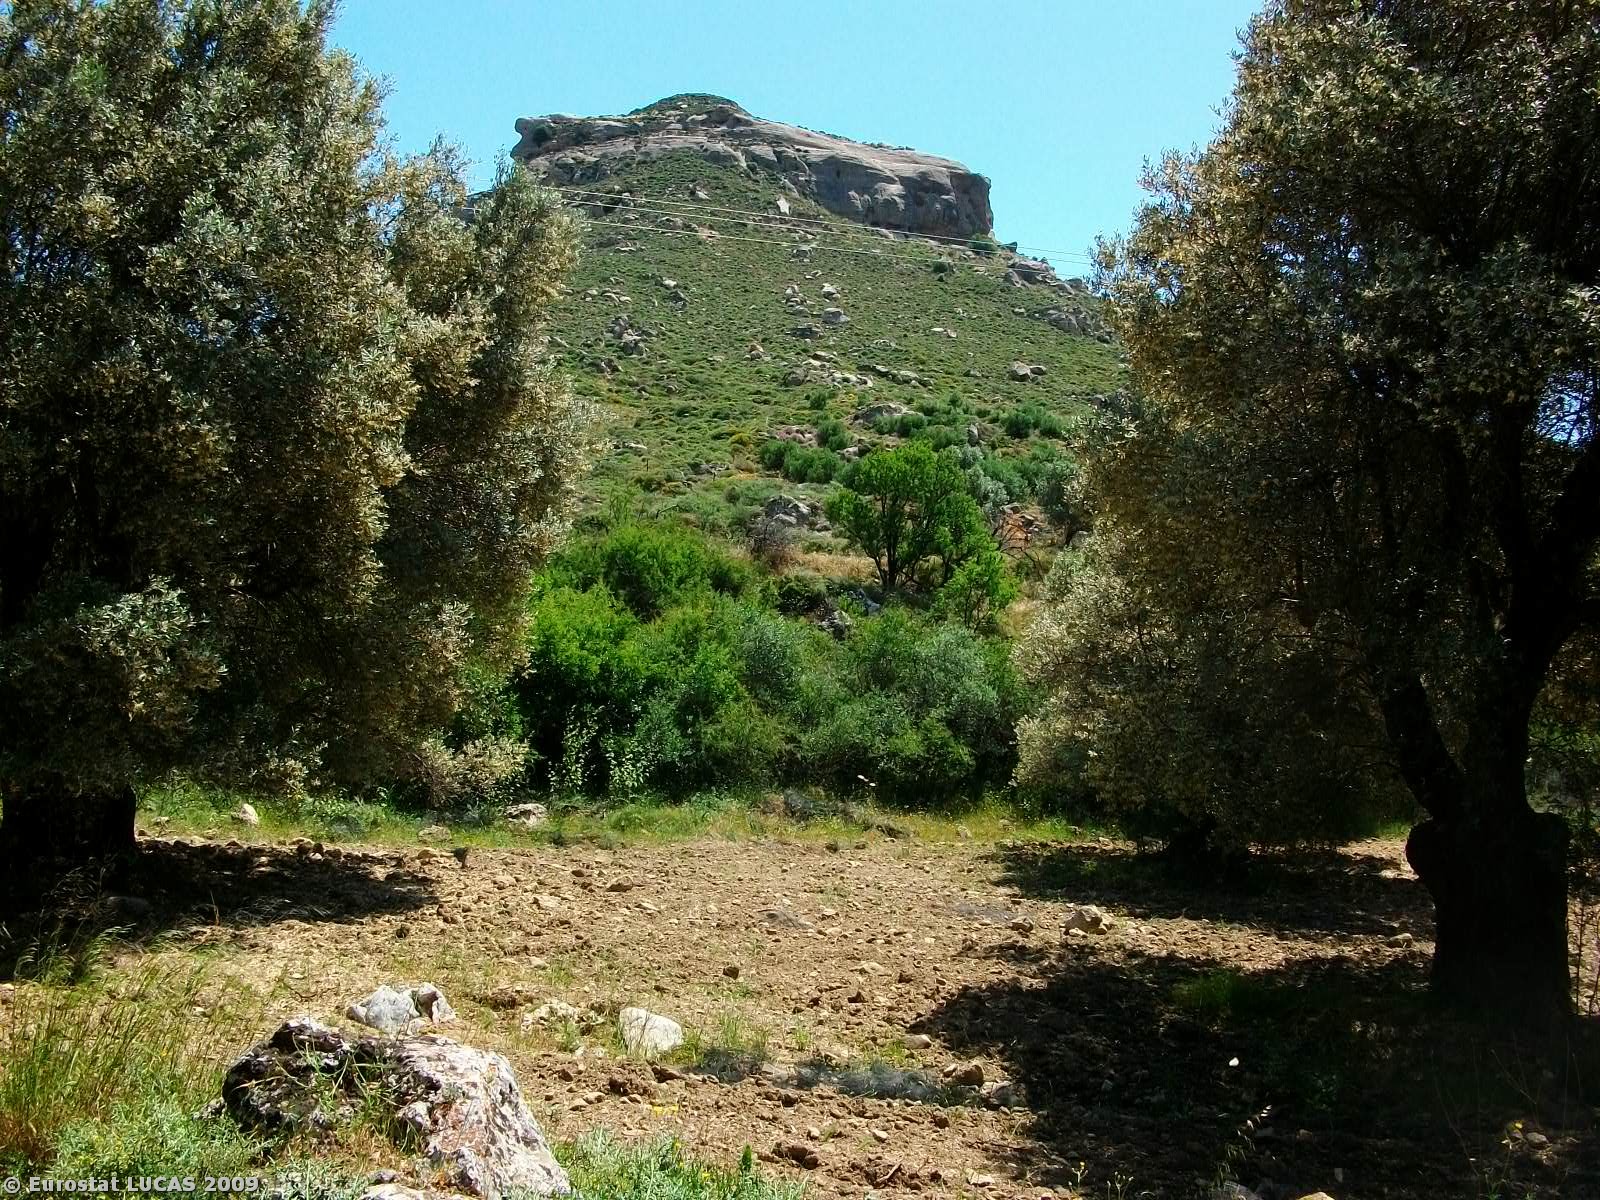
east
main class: Cropland
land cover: Olive groves
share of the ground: > 75 %
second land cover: Bare land
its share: > 75 %
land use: Agriculture (excluding fallow land and kitchen gardens)
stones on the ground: 10 - 25 %
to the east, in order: Olive groves; Bare land; Shrubland with sparse tree cover; Electric lines; Grass margins; Paved roads, cycling and walking lanes; Grass margins; Fences; Olive groves; Grassland with sparse tree/shrub cover; Shrubland without tree cover
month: May
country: GR
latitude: 35.1368
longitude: 24.9684
